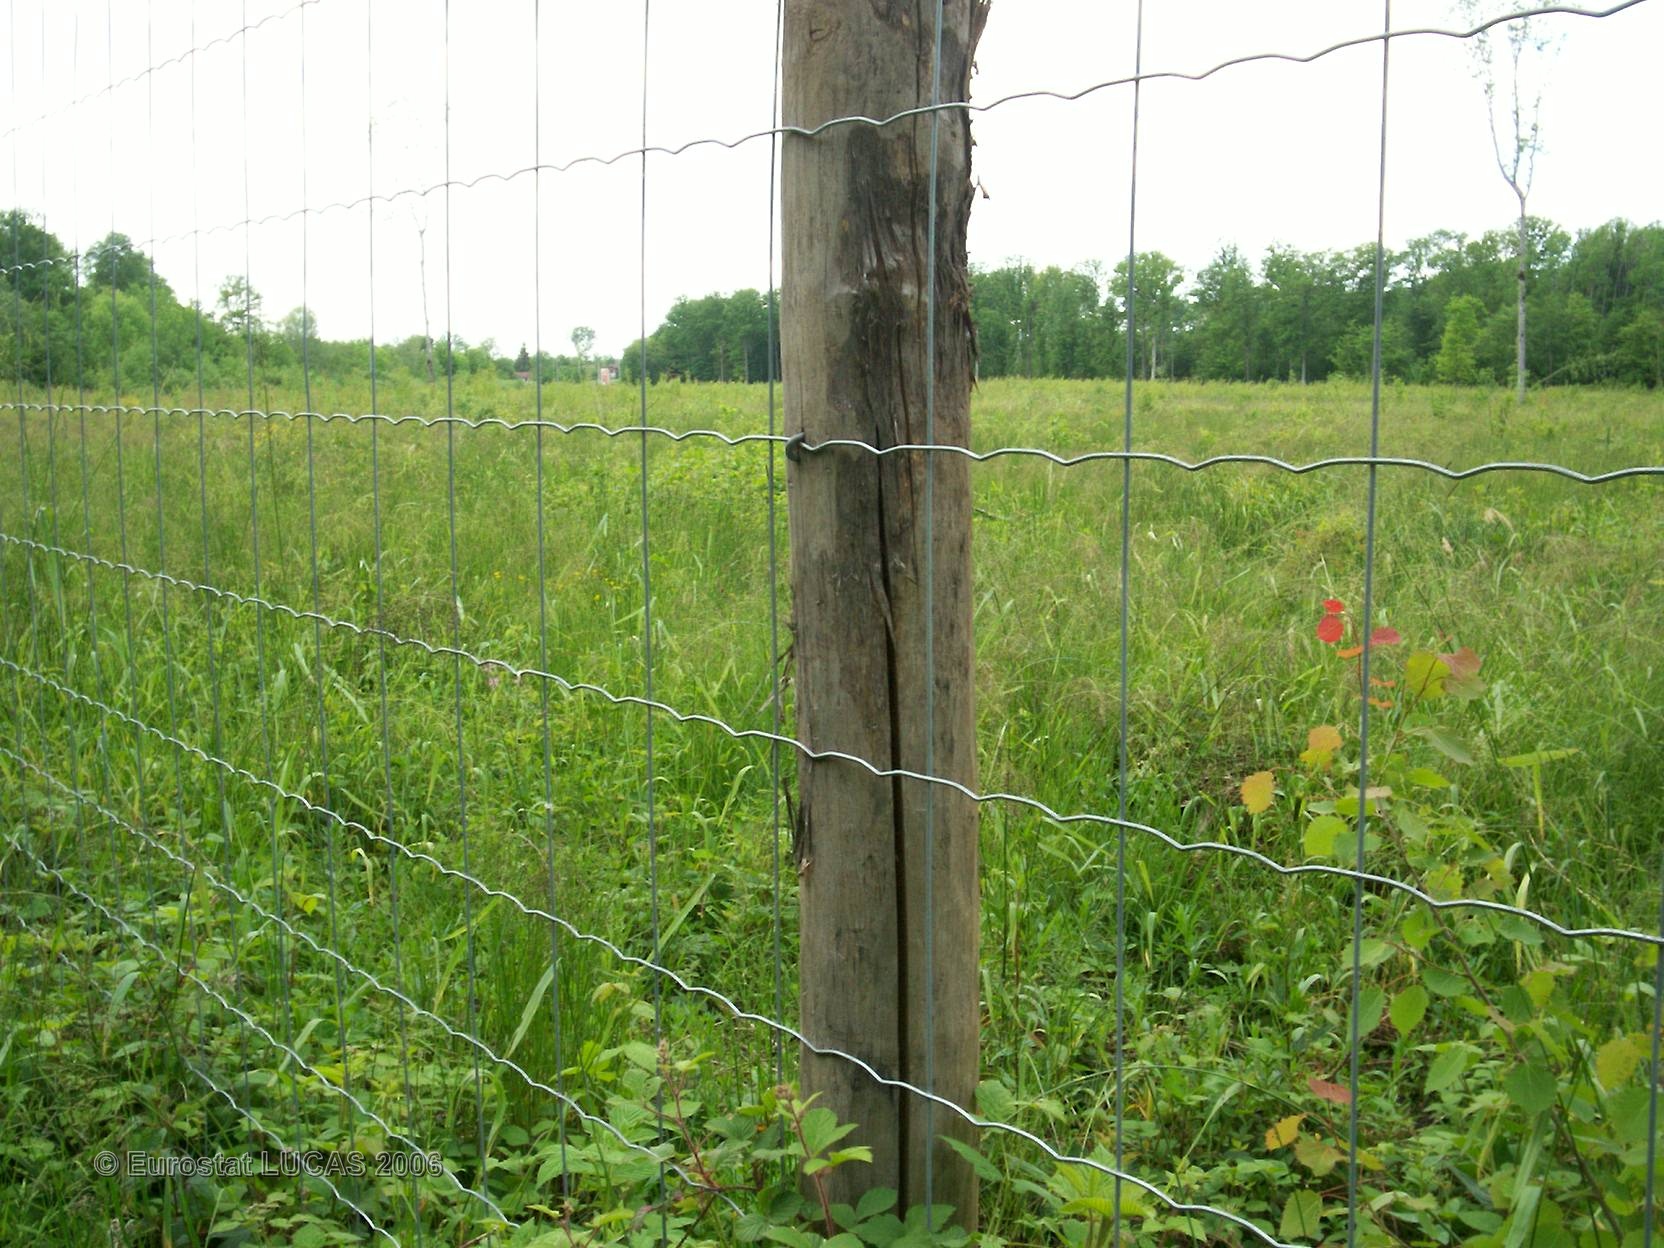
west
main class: Grassland
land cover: Grassland without tree/shrub cover
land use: Agriculture (excluding fallow land and kitchen gardens)
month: May
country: FR
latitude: 48.3650
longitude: 4.6662
